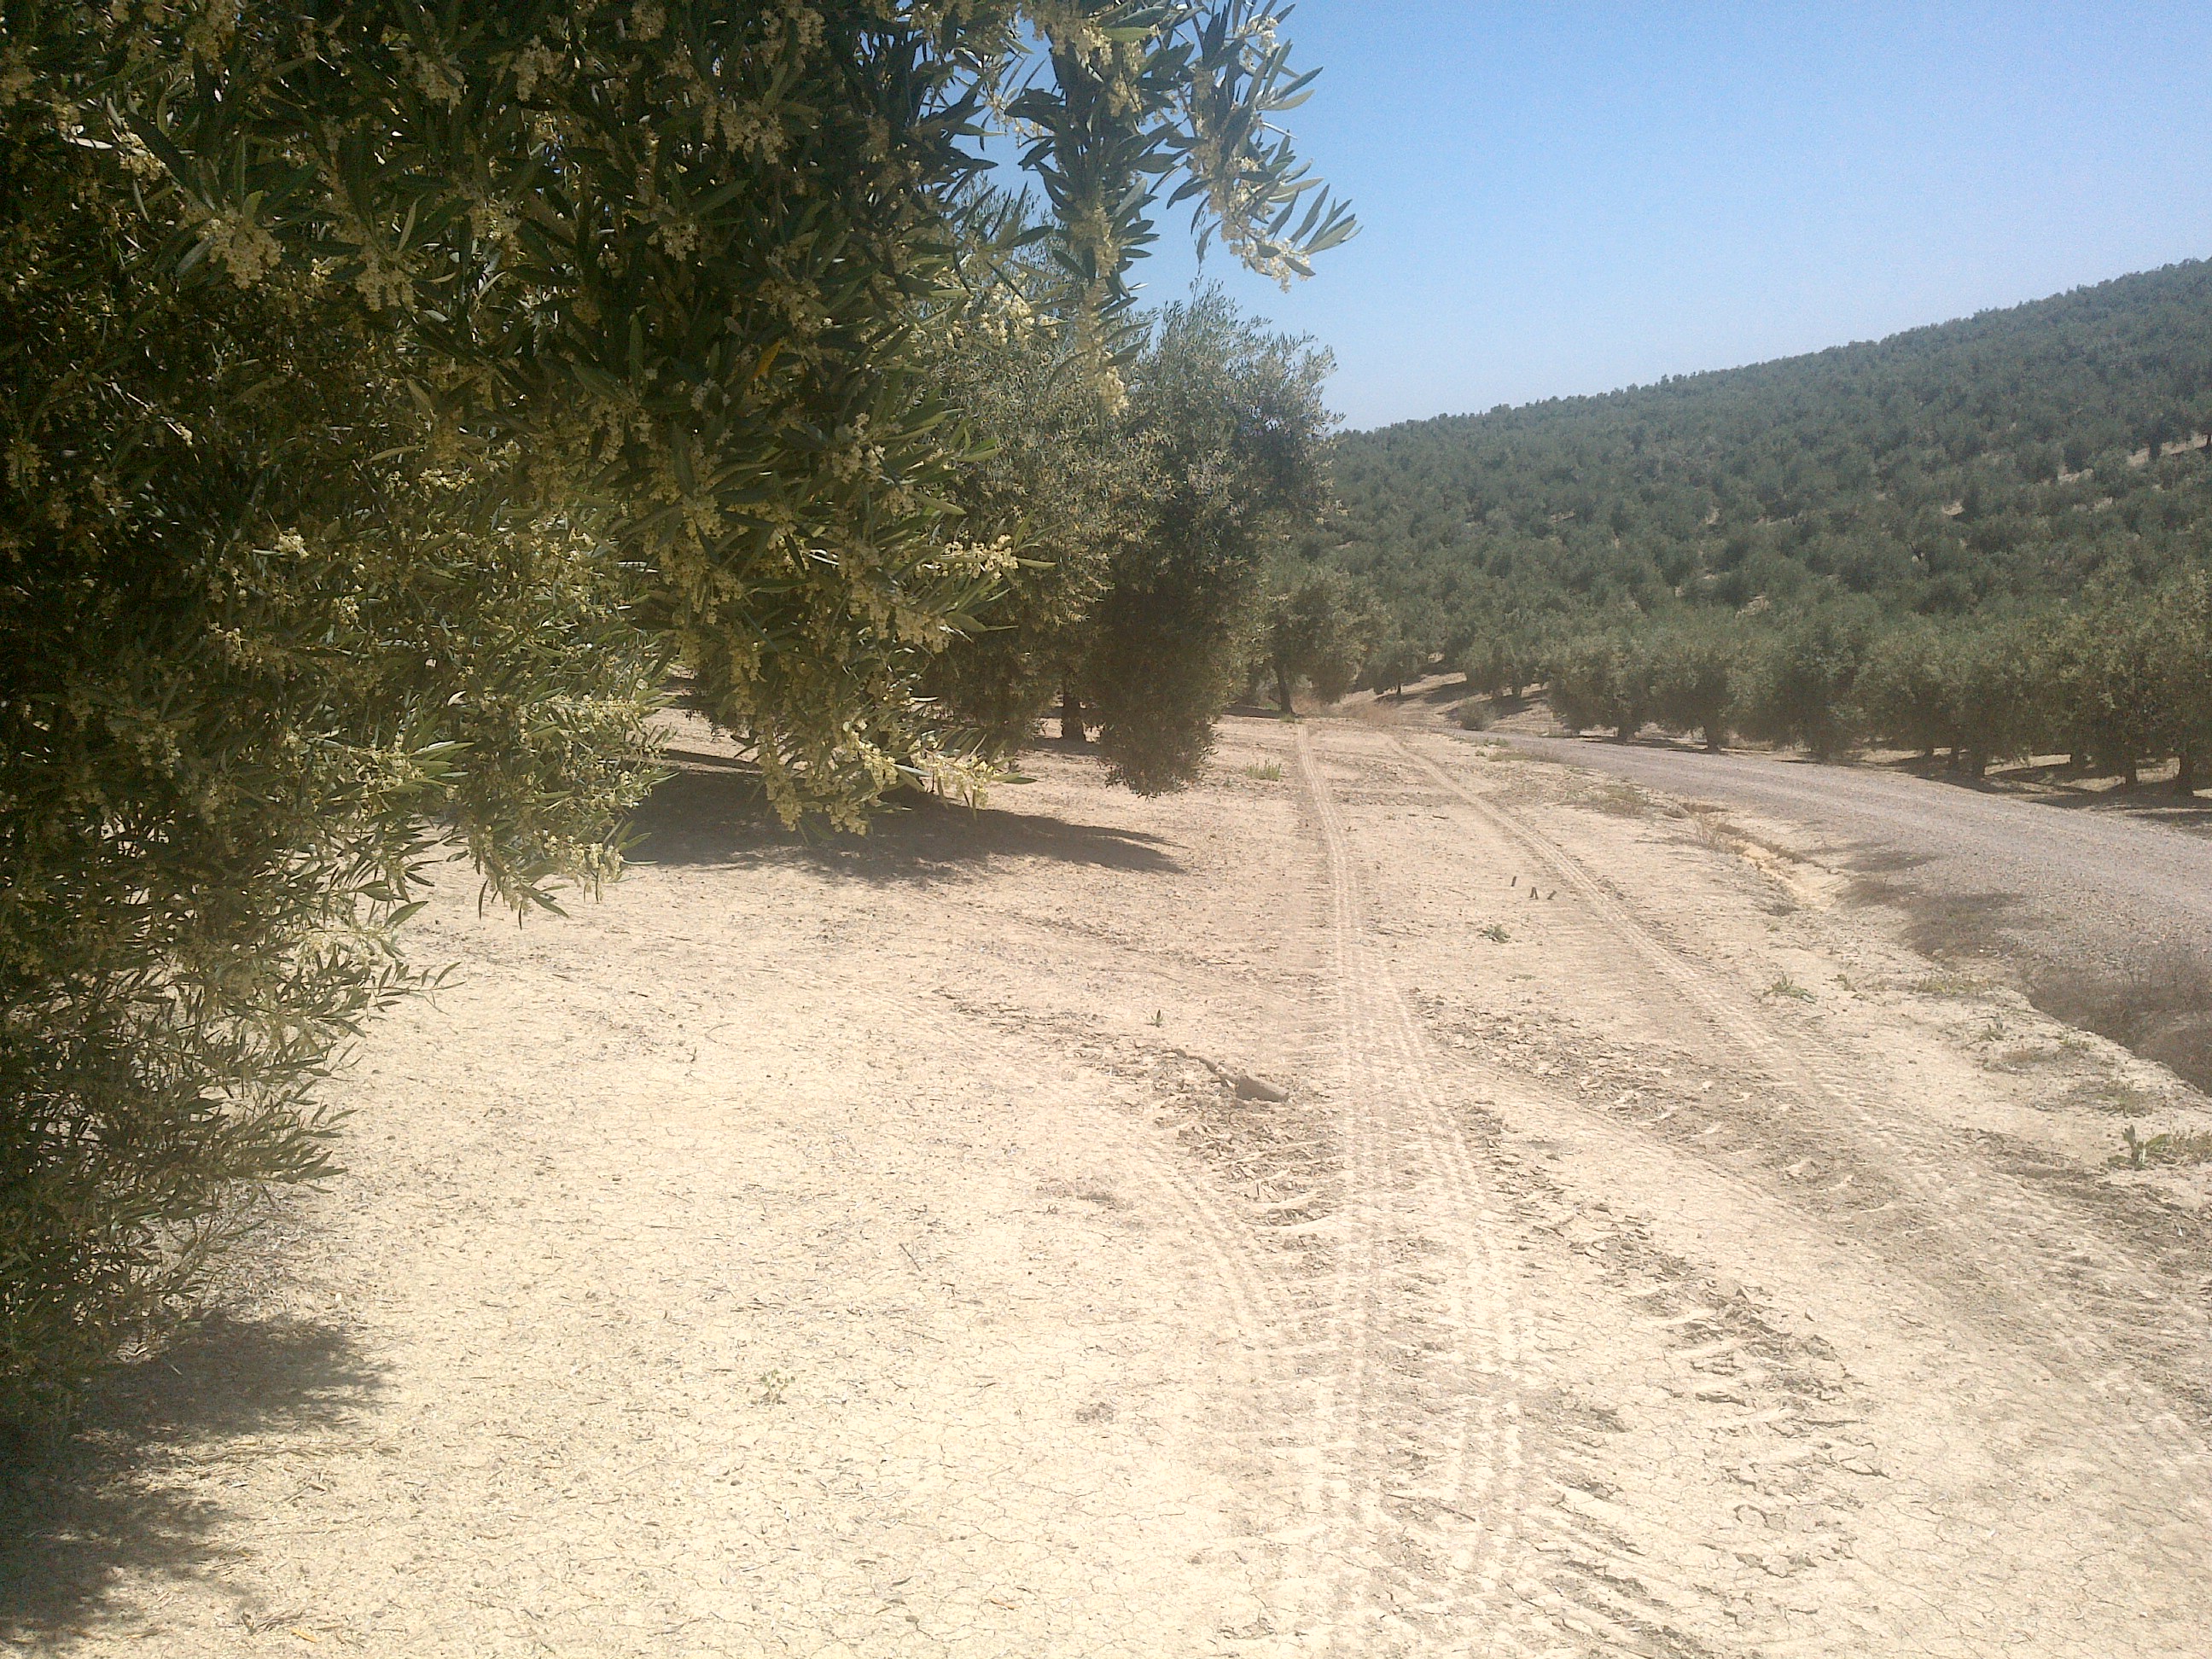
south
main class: Cropland
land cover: Olive groves
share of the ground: 50 - 75 %
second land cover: Other bare soil
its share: > 75 %
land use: Agriculture (excluding fallow land and kitchen gardens)
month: May
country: ES
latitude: 37.7694
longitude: -4.6210
